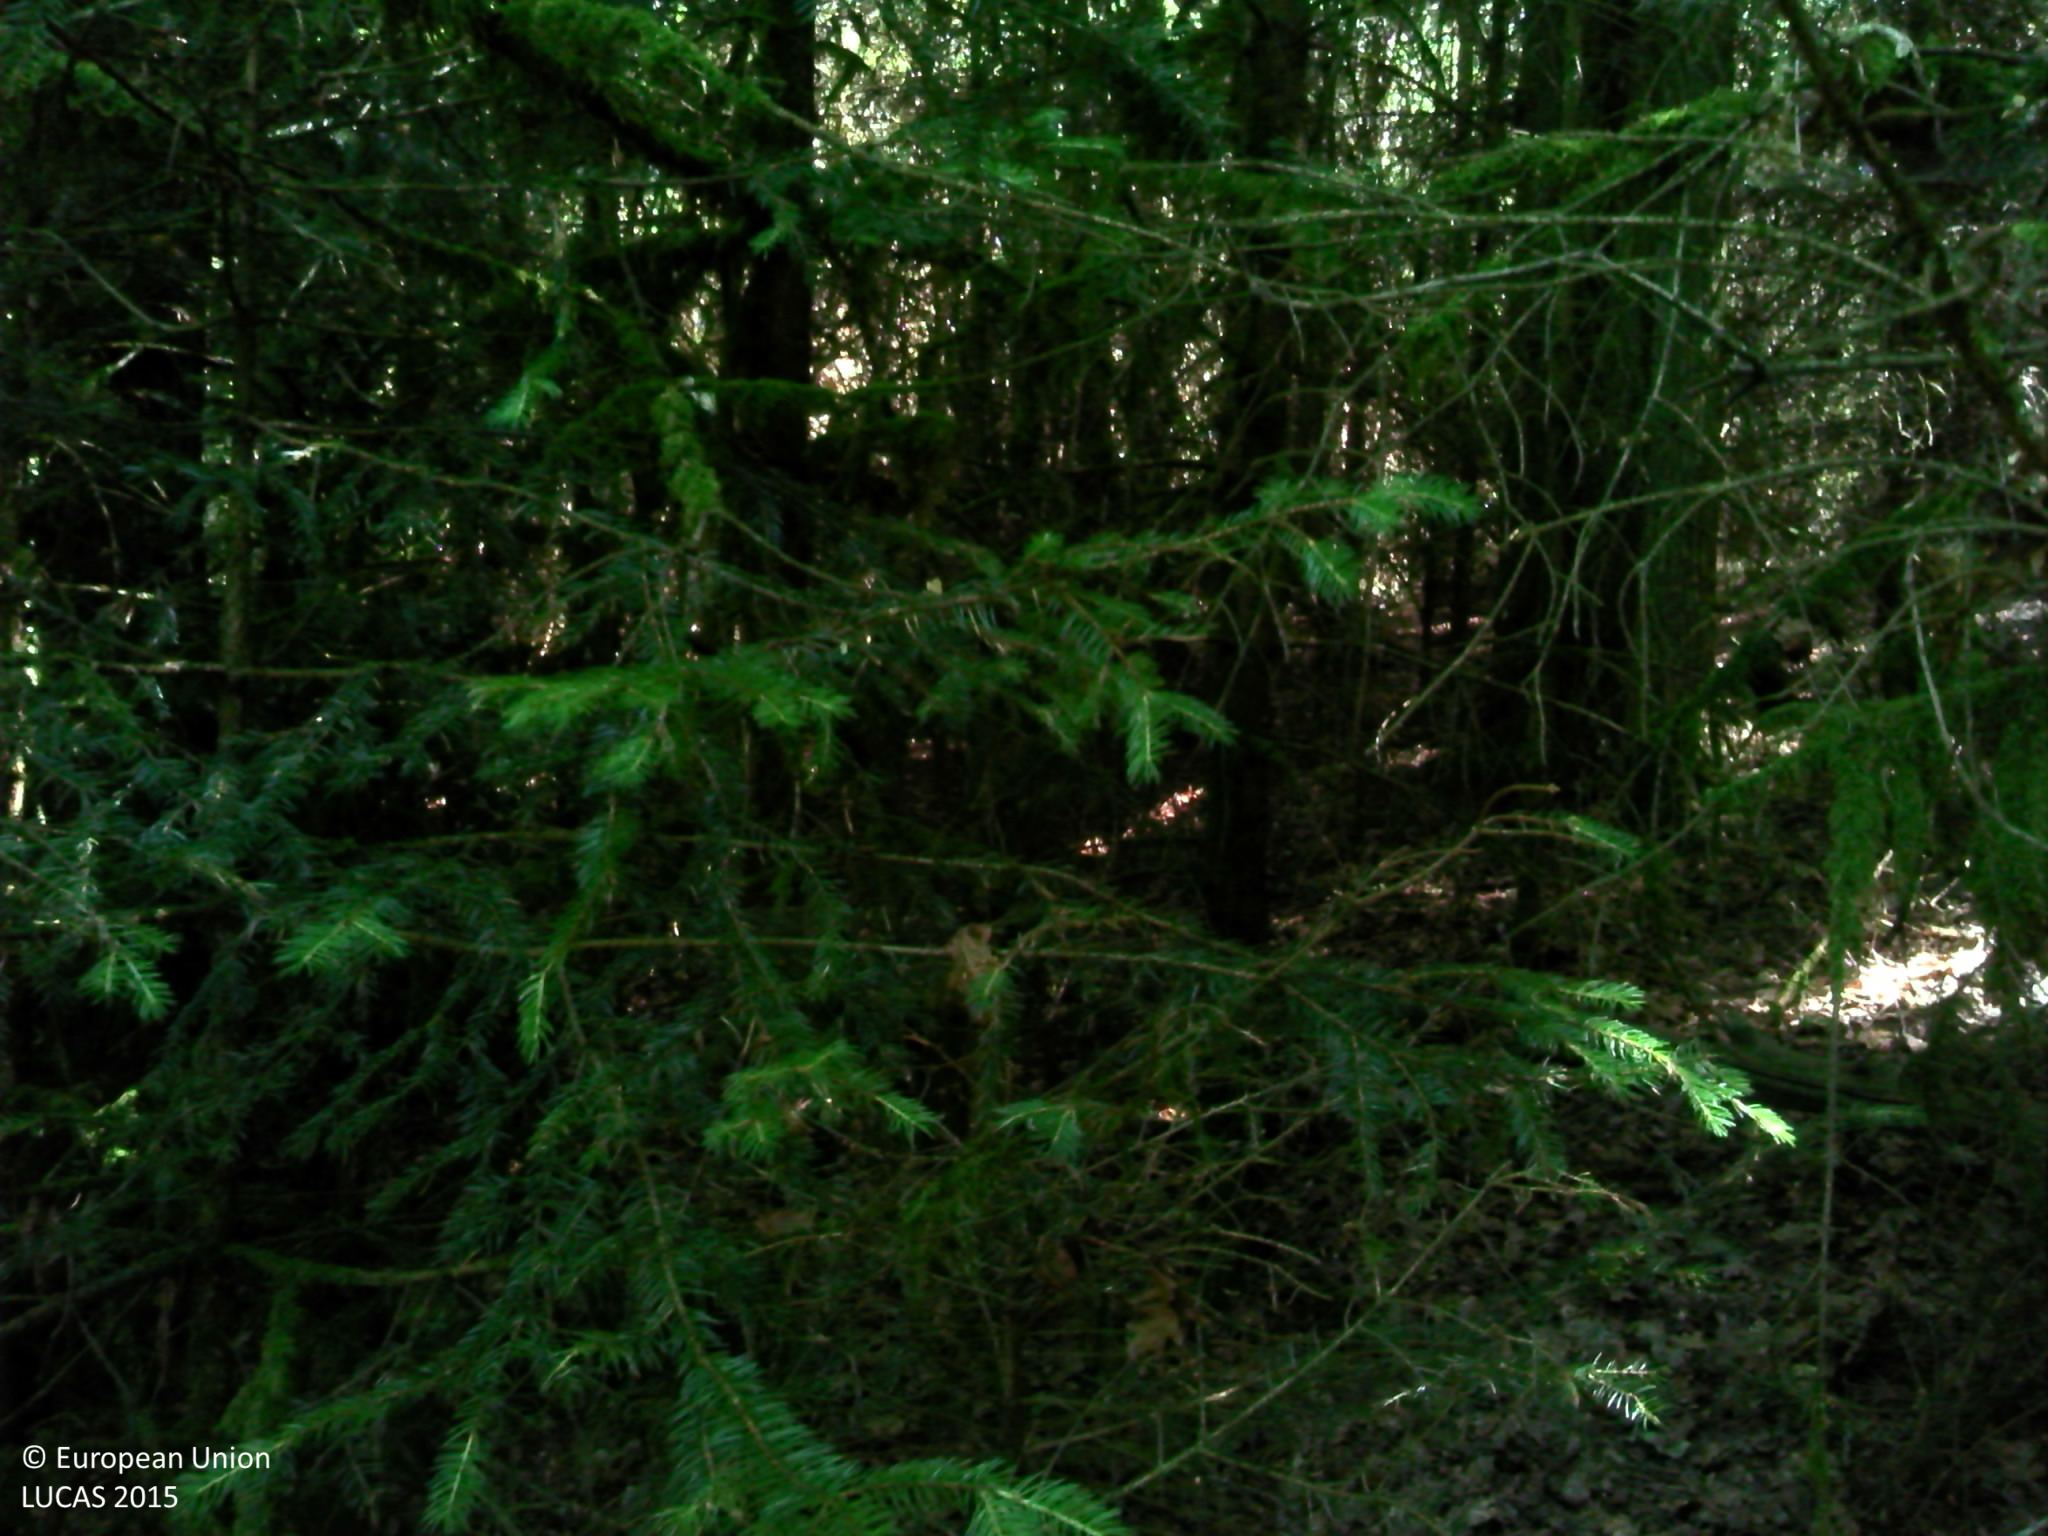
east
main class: Woodland
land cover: Spruce dominated mixed woodland
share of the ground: > 75 %
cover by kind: broadleaved forest trees 60 %, coniferous forest trees 40 %
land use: Forestry
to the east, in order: Spruce dominated mixed woodland; Spruce dominated coniferous woodland; Tracks; Spruce dominated mixed woodland; Rivers and streams; Fences; Grassland without tree/shrub cover; Fences; Shrubland without tree cover; Abandoned hedges; Fences; Grassland without tree/shrub cover
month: July
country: BE
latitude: 50.0801
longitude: 5.5685
